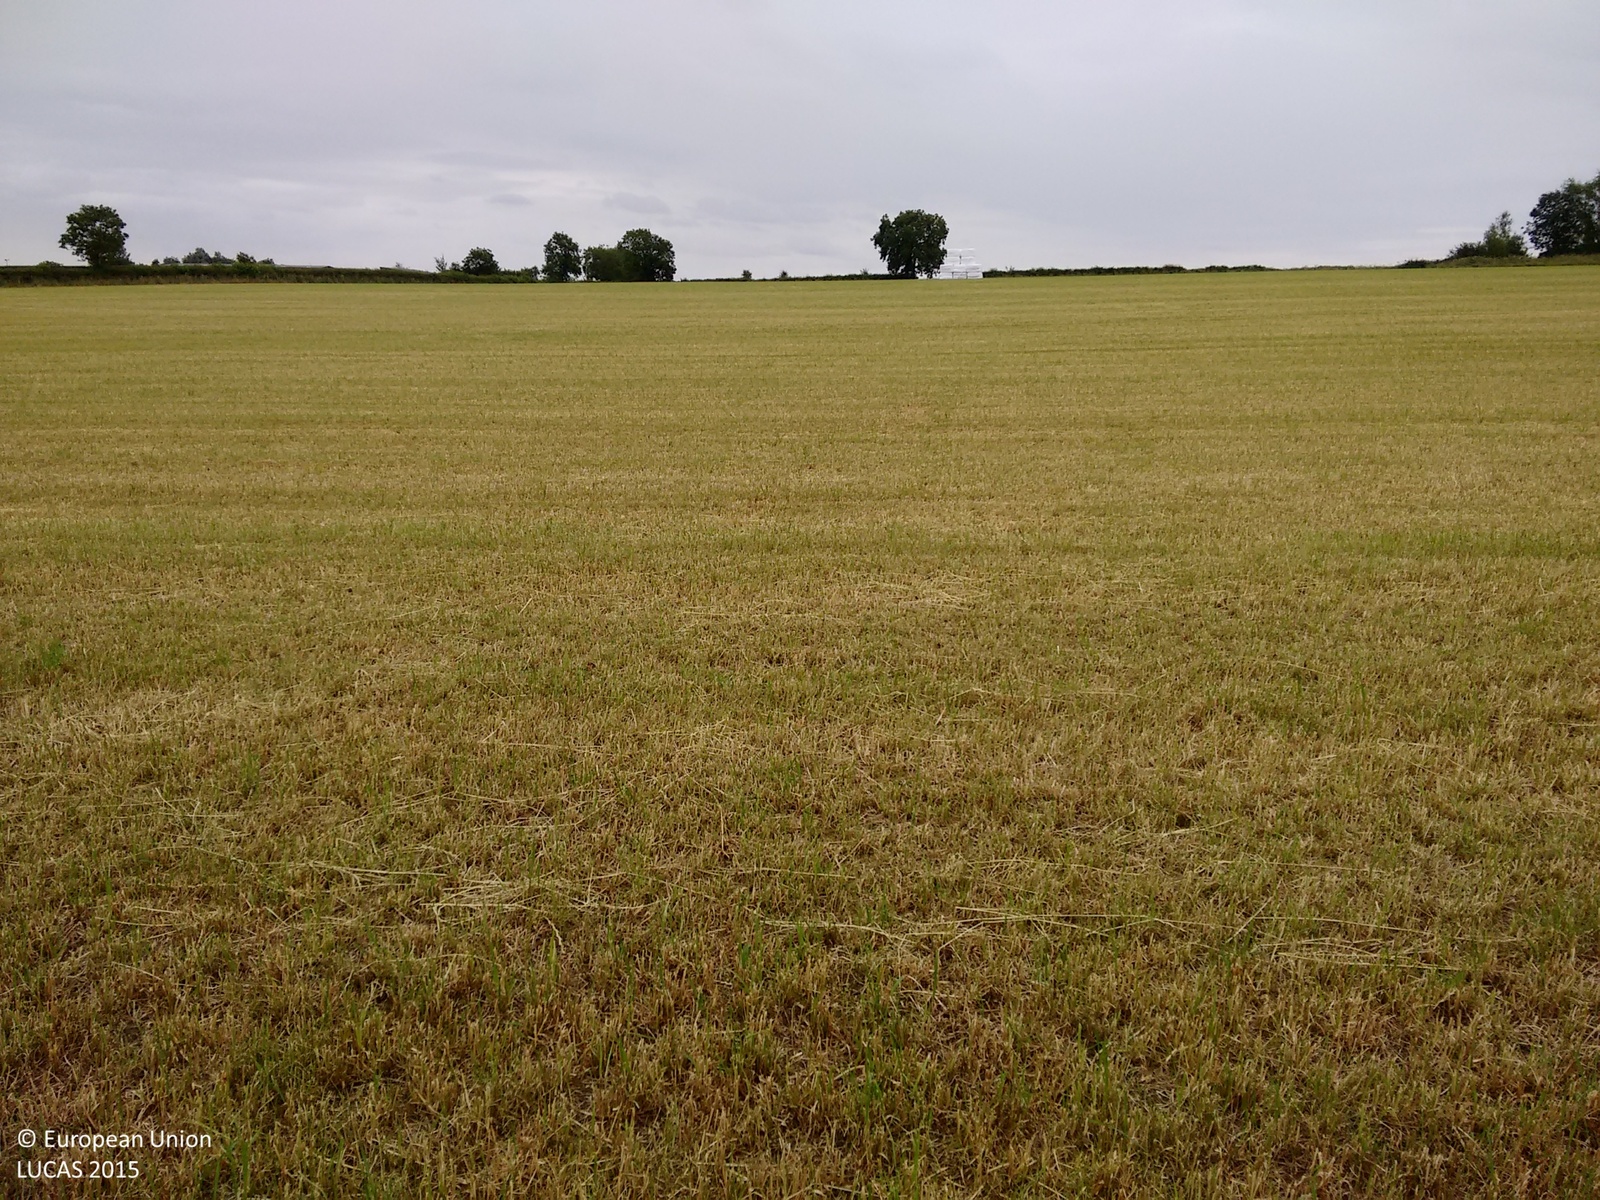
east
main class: Grassland
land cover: Grassland without tree/shrub cover
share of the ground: > 75 %
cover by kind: herbaceous plants 100 %
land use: Agriculture (excluding fallow land and kitchen gardens)
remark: Harvested field
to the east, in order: Grassland without tree/shrub cover; Single bushes/trees; Fences; Grassland without tree/shrub cover
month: July
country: GB
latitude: 52.8255
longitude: -1.0115
